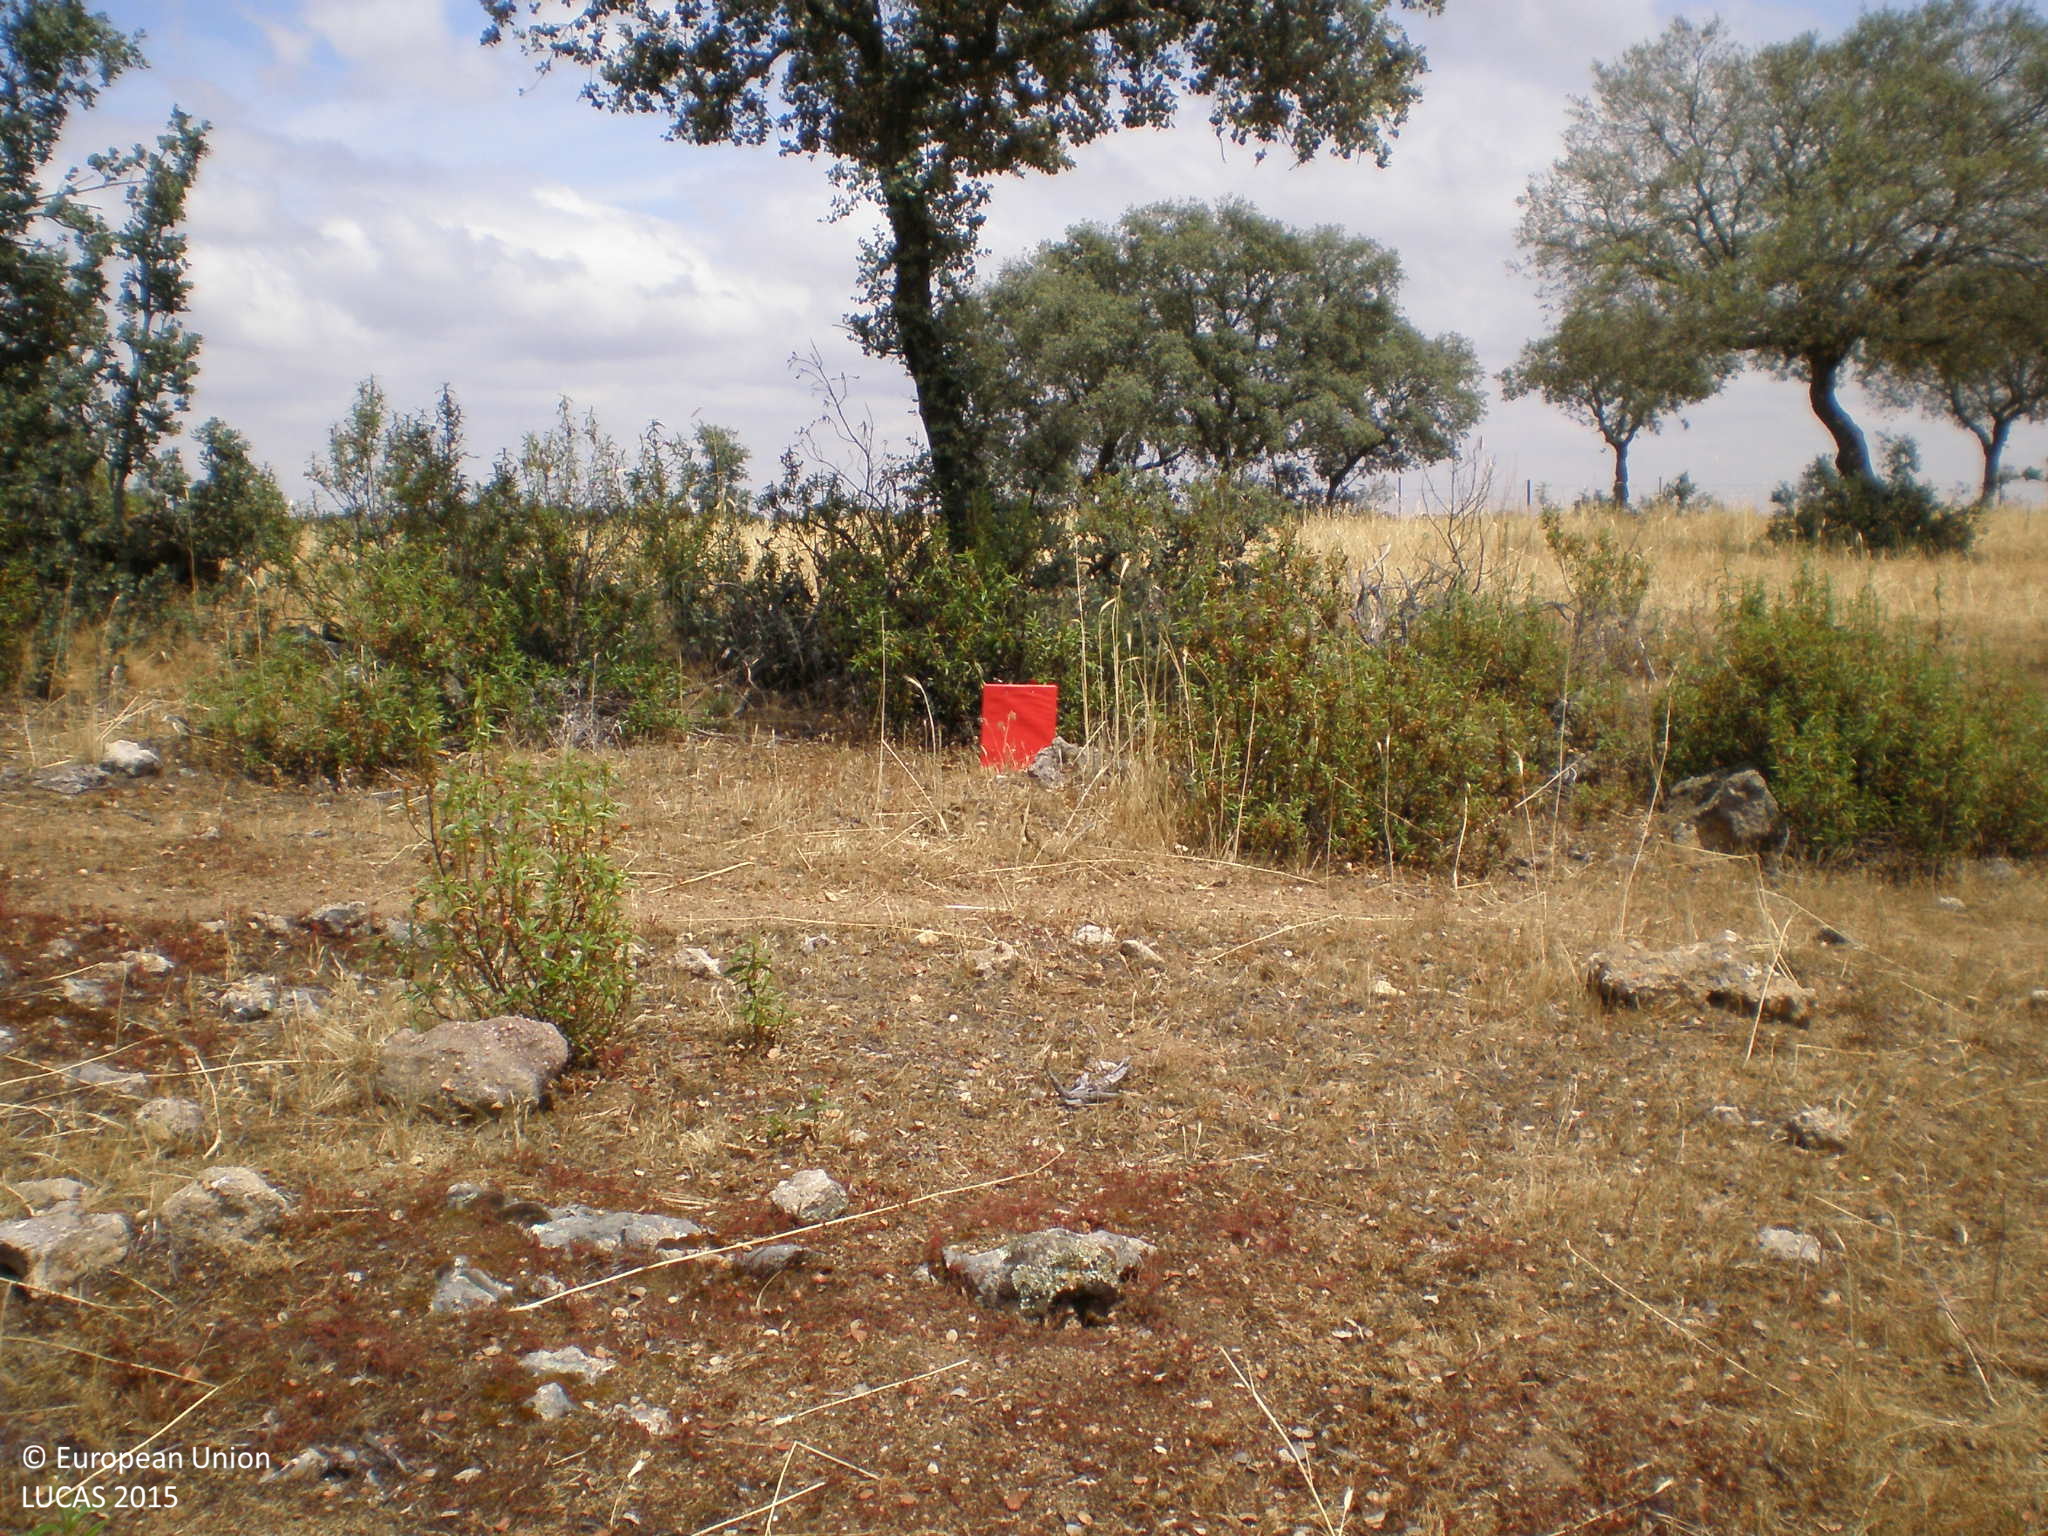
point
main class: Woodland
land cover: Broadleaved woodland
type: broadleaved evergreen forest
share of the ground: 25 - 50 %
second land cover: Rye
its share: 50 - 75 %
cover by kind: herbaceous plants 70 %, broadleaved forest trees 30 %
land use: Forestry
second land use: Agriculture (excluding fallow land and kitchen gardens)
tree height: < 5 m
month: June
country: ES
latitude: 41.1376
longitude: -5.7474
